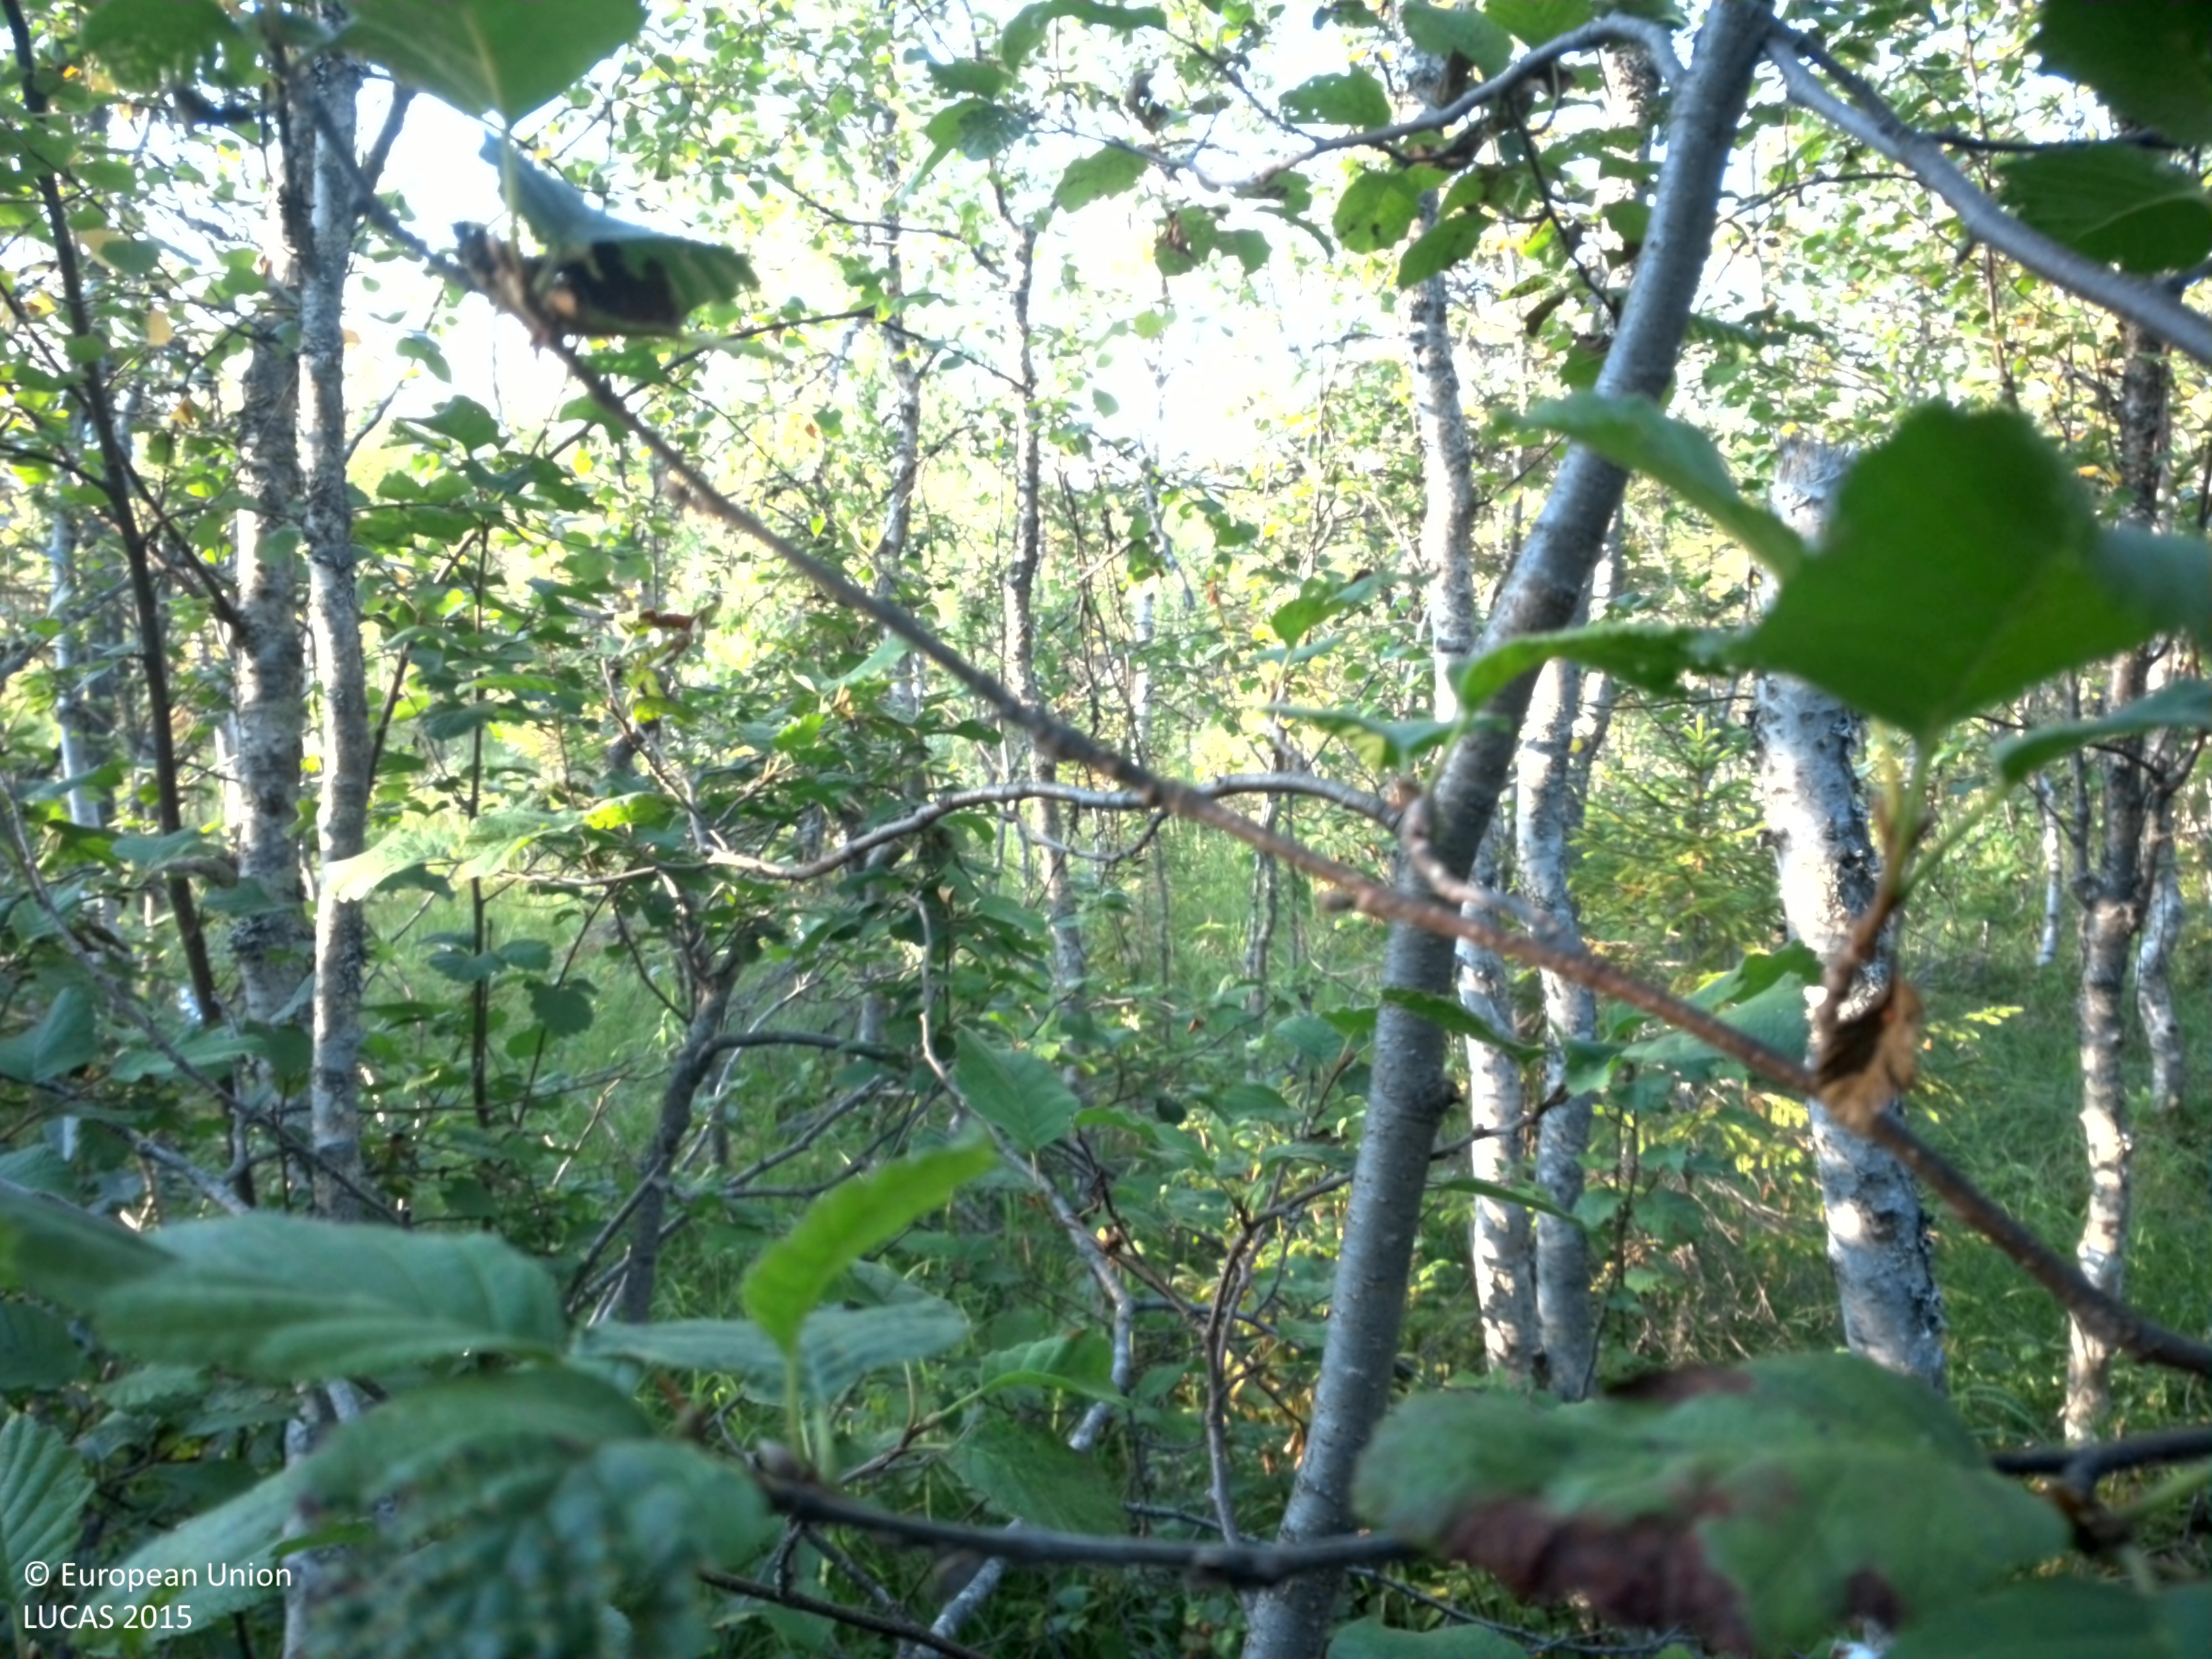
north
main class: Woodland
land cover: Broadleaved woodland
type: non-riverine alder, birch or aspen forest
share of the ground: 50 - 75 %
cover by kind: broadleaved forest trees 60 %, herbaceous plants 25 %, shrubs 10 %, coniferous forest trees 5 %
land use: Semi-natural and natural areas not in use
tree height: > 5 m
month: August
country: SE
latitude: 64.7835
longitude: 16.6765
